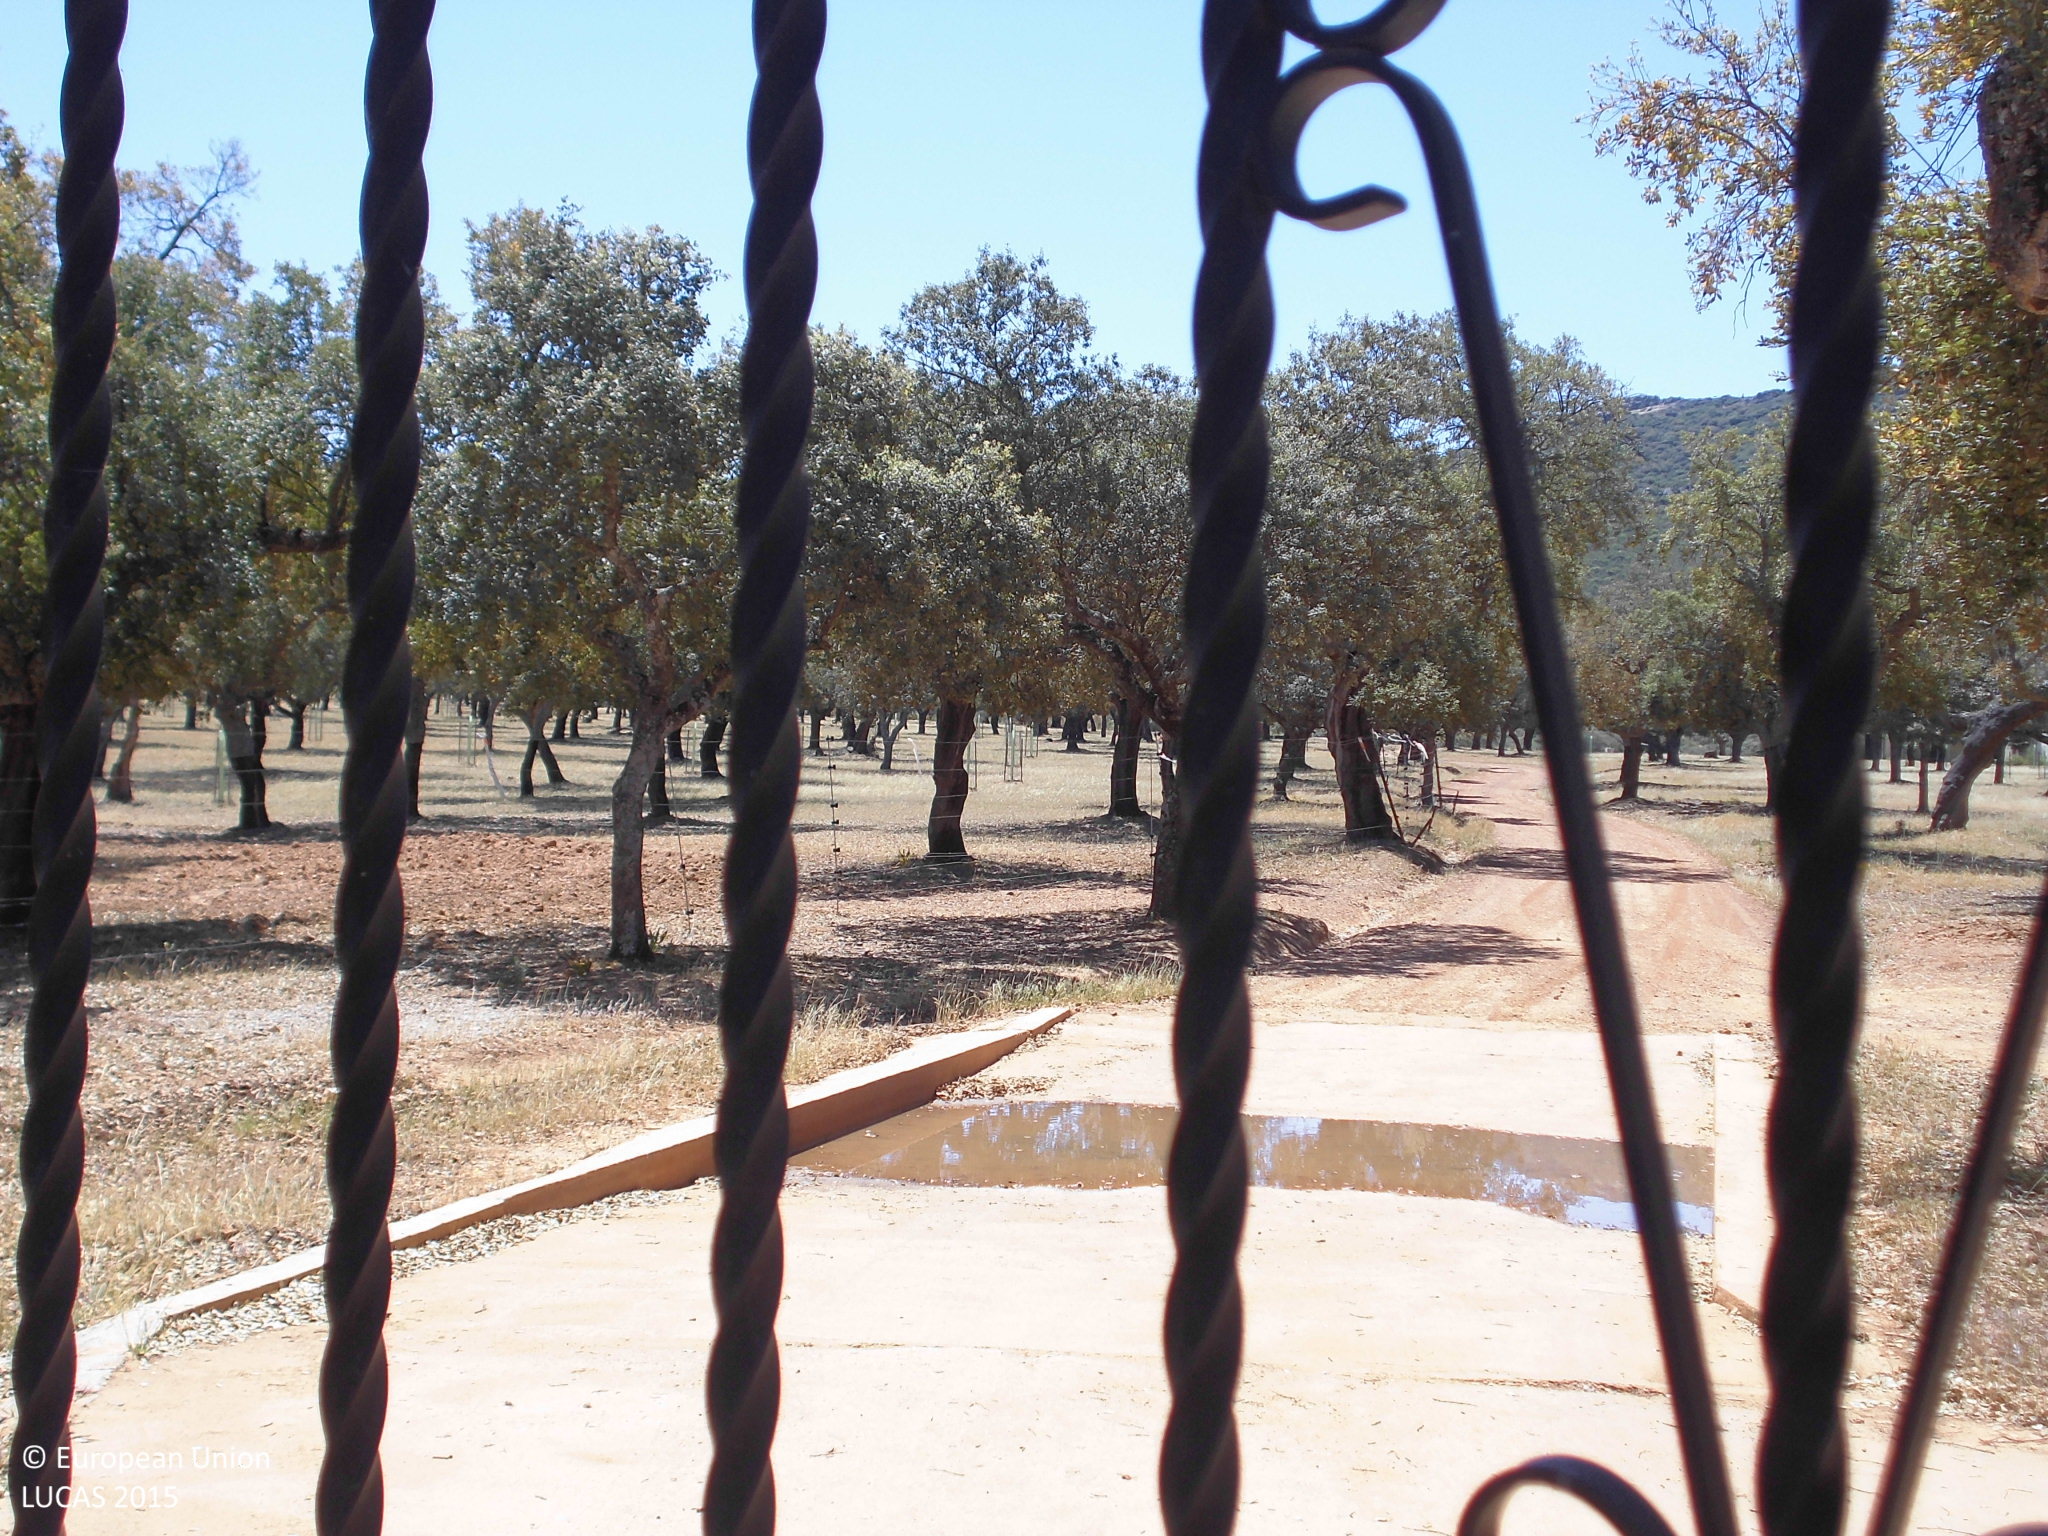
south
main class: Woodland
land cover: Broadleaved woodland
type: broadleaved evergreen forest
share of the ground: 25 - 50 %
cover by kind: herbaceous plants 55 %, broadleaved forest trees 30 %, shrubs 15 %
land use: Forestry
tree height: > 5 m
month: May
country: ES
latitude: 39.4067
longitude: -6.9534
